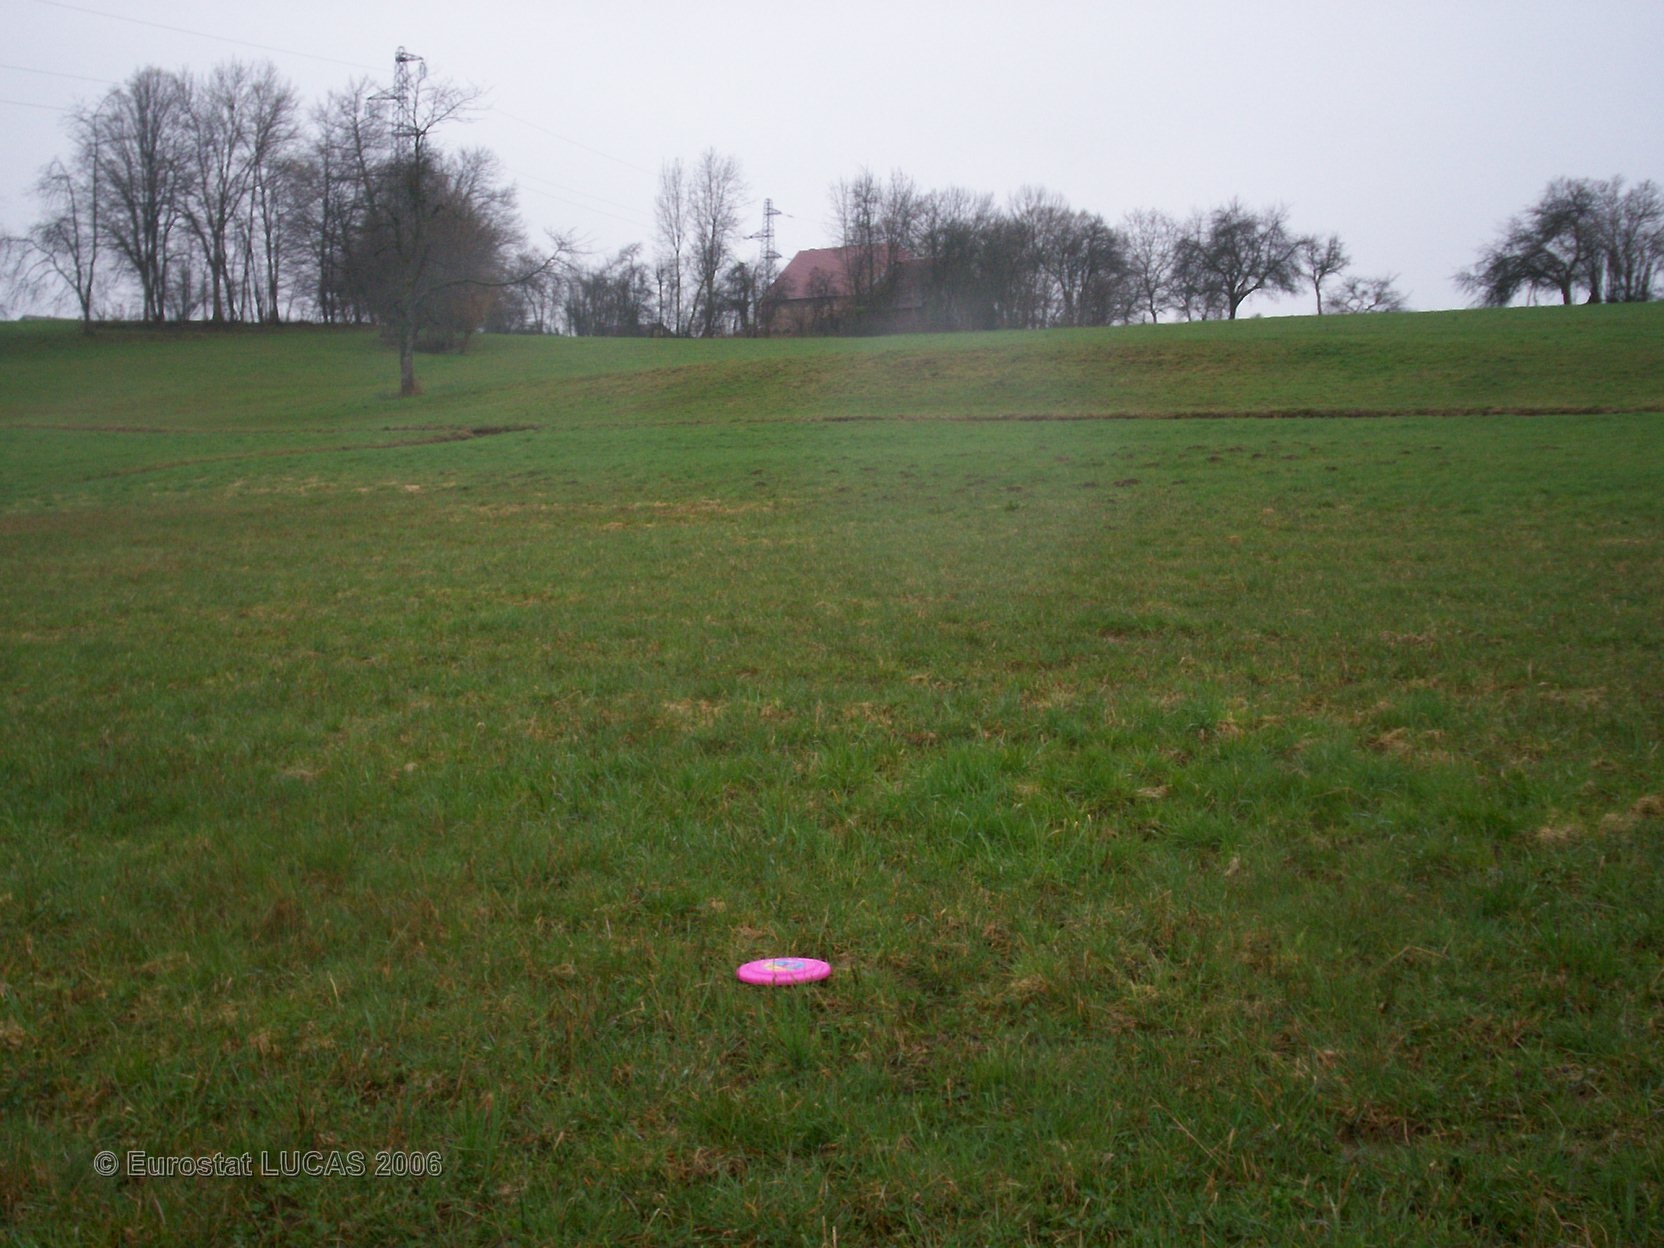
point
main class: Grassland
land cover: Grassland without tree/shrub cover
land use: Agriculture (excluding fallow land and kitchen gardens)
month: April
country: FR
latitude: 47.6661
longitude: 6.5789
